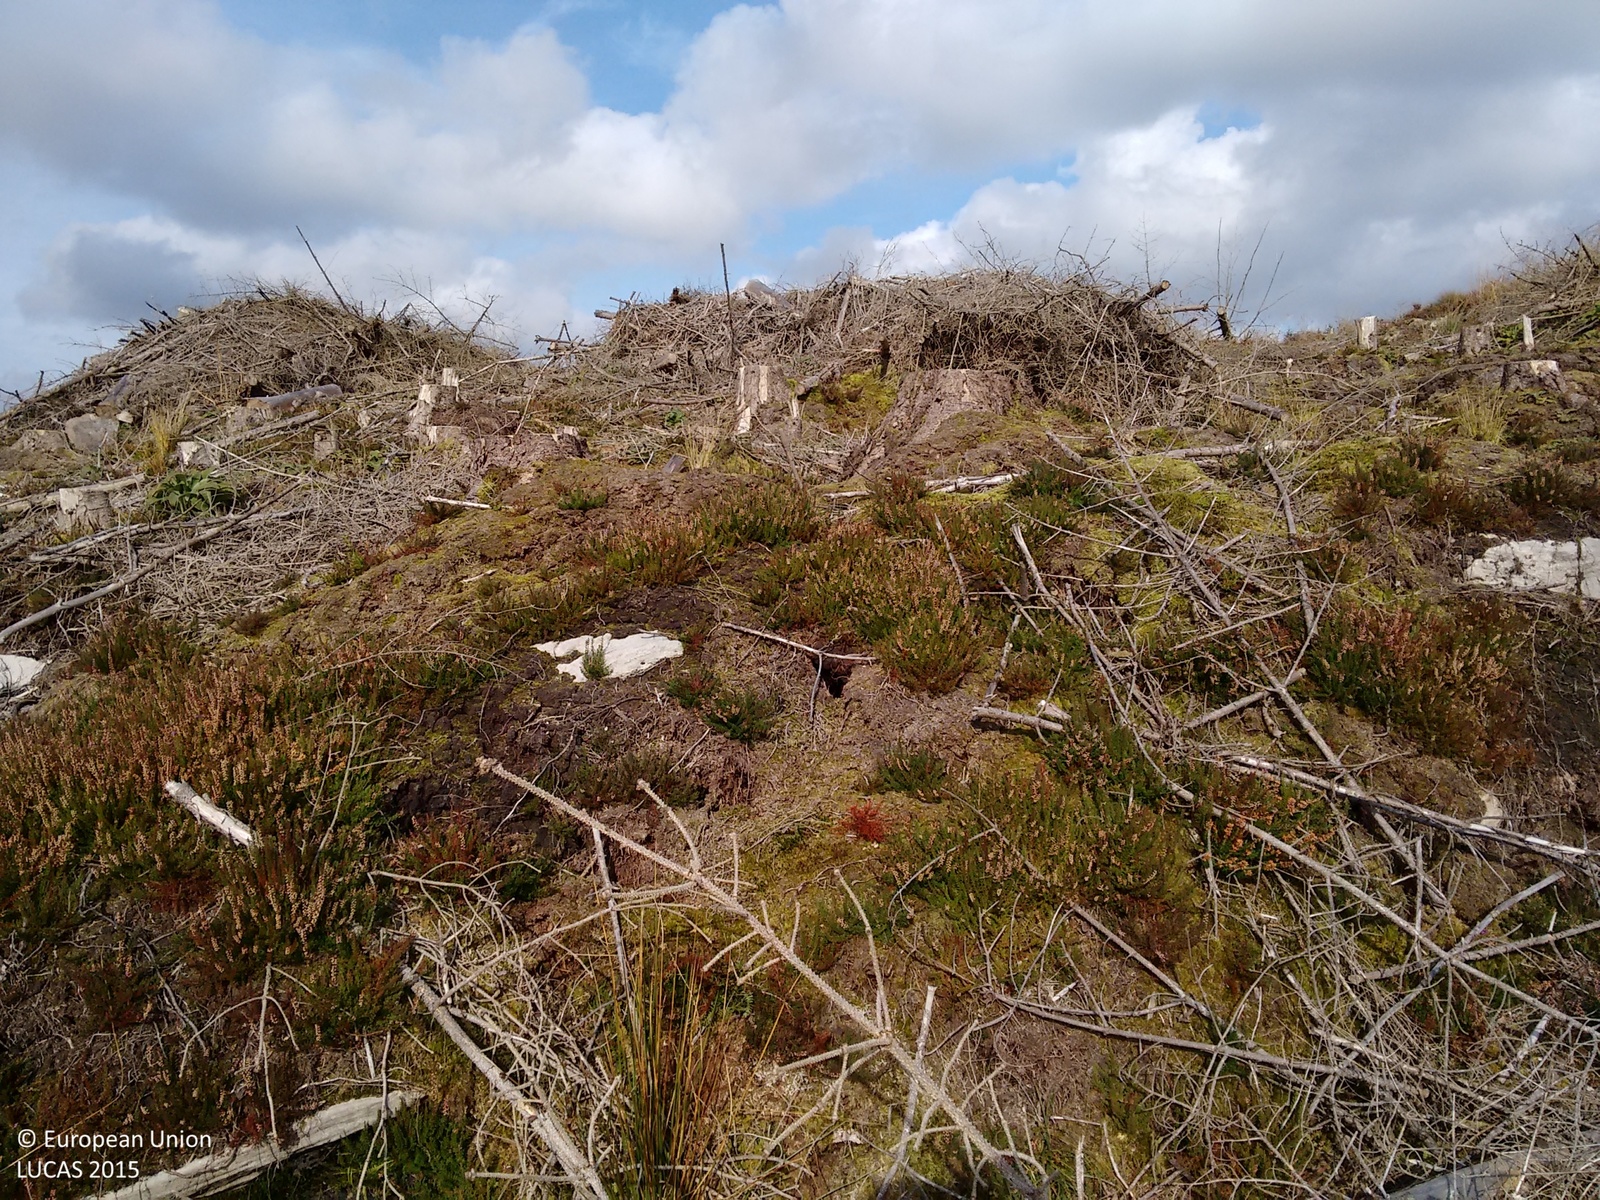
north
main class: Grassland
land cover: Grassland without tree/shrub cover
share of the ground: > 75 %
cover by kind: herbaceous plants 55 %, unconsolidated bare surface 25 %, lichens and mosses 20 %
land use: Forestry
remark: Clear cut
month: October
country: GB
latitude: 54.3222
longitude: -7.8968
